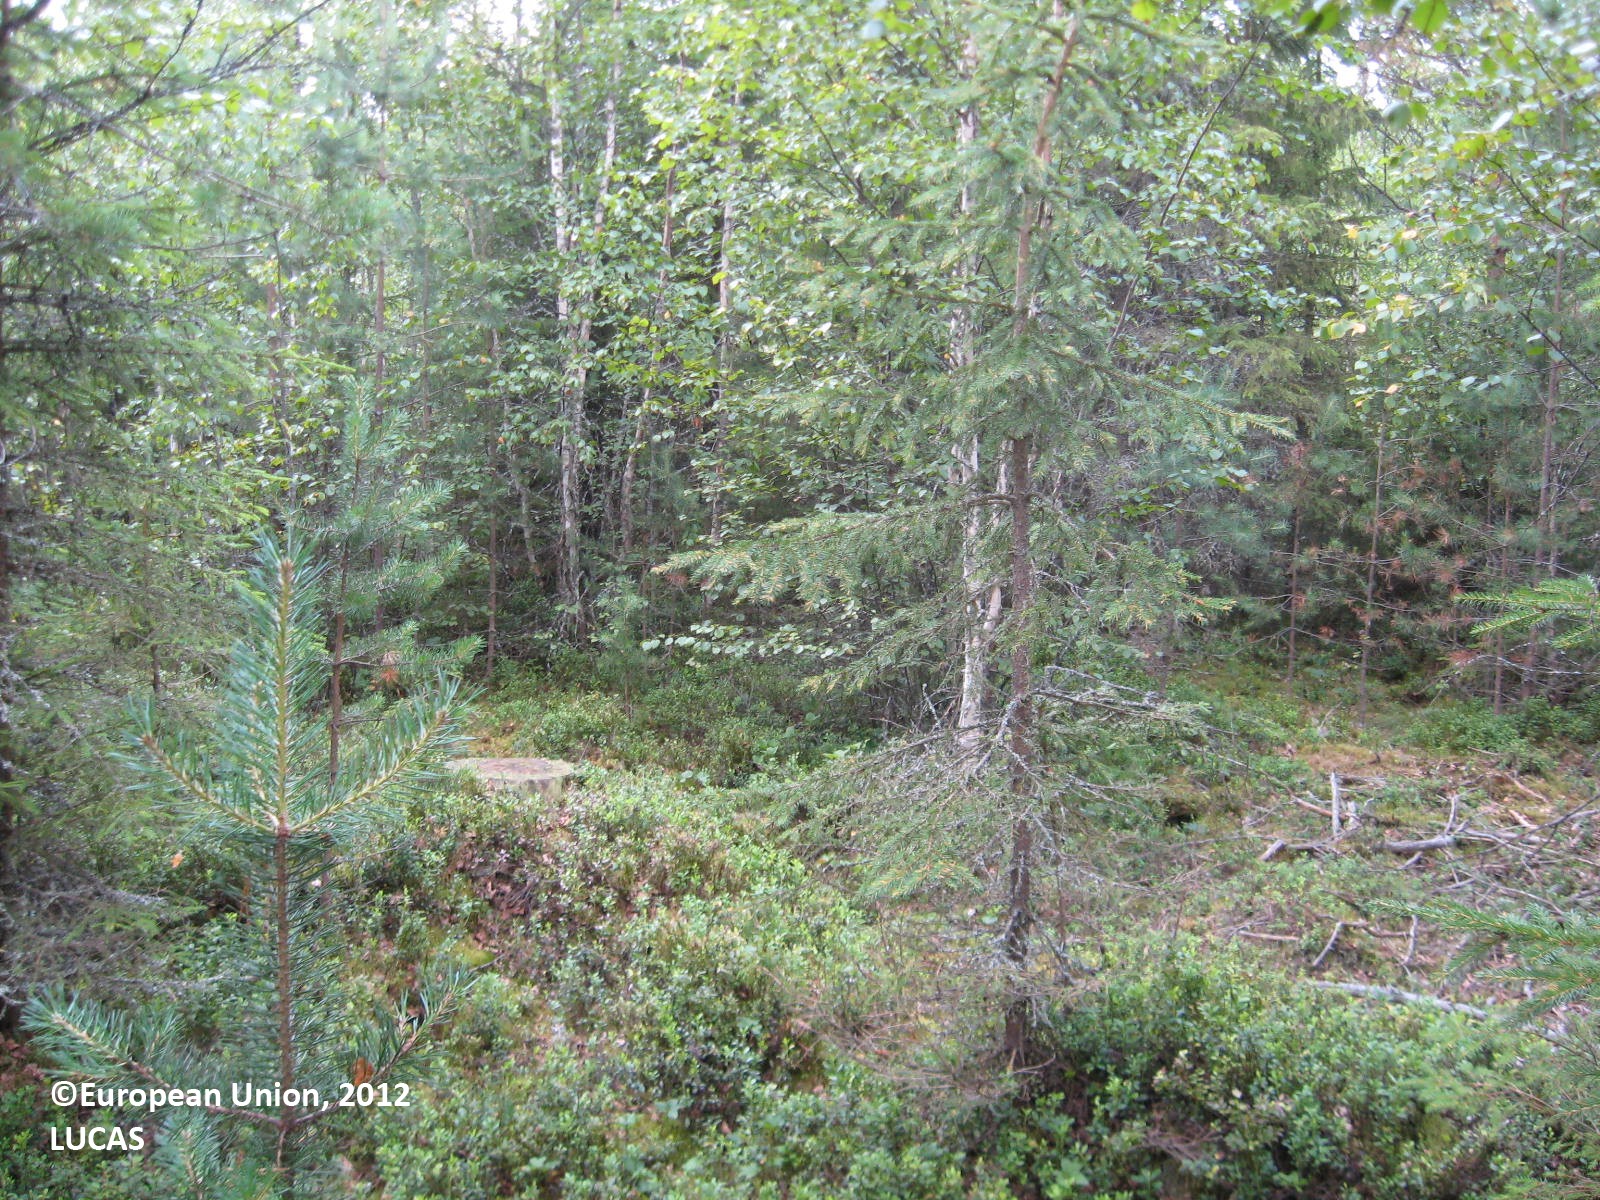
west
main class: Woodland
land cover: Other mixed woodland
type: boreal forest
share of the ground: > 75 %
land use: Forestry
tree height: > 5 m
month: July
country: FI
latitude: 61.8571
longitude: 22.4320
